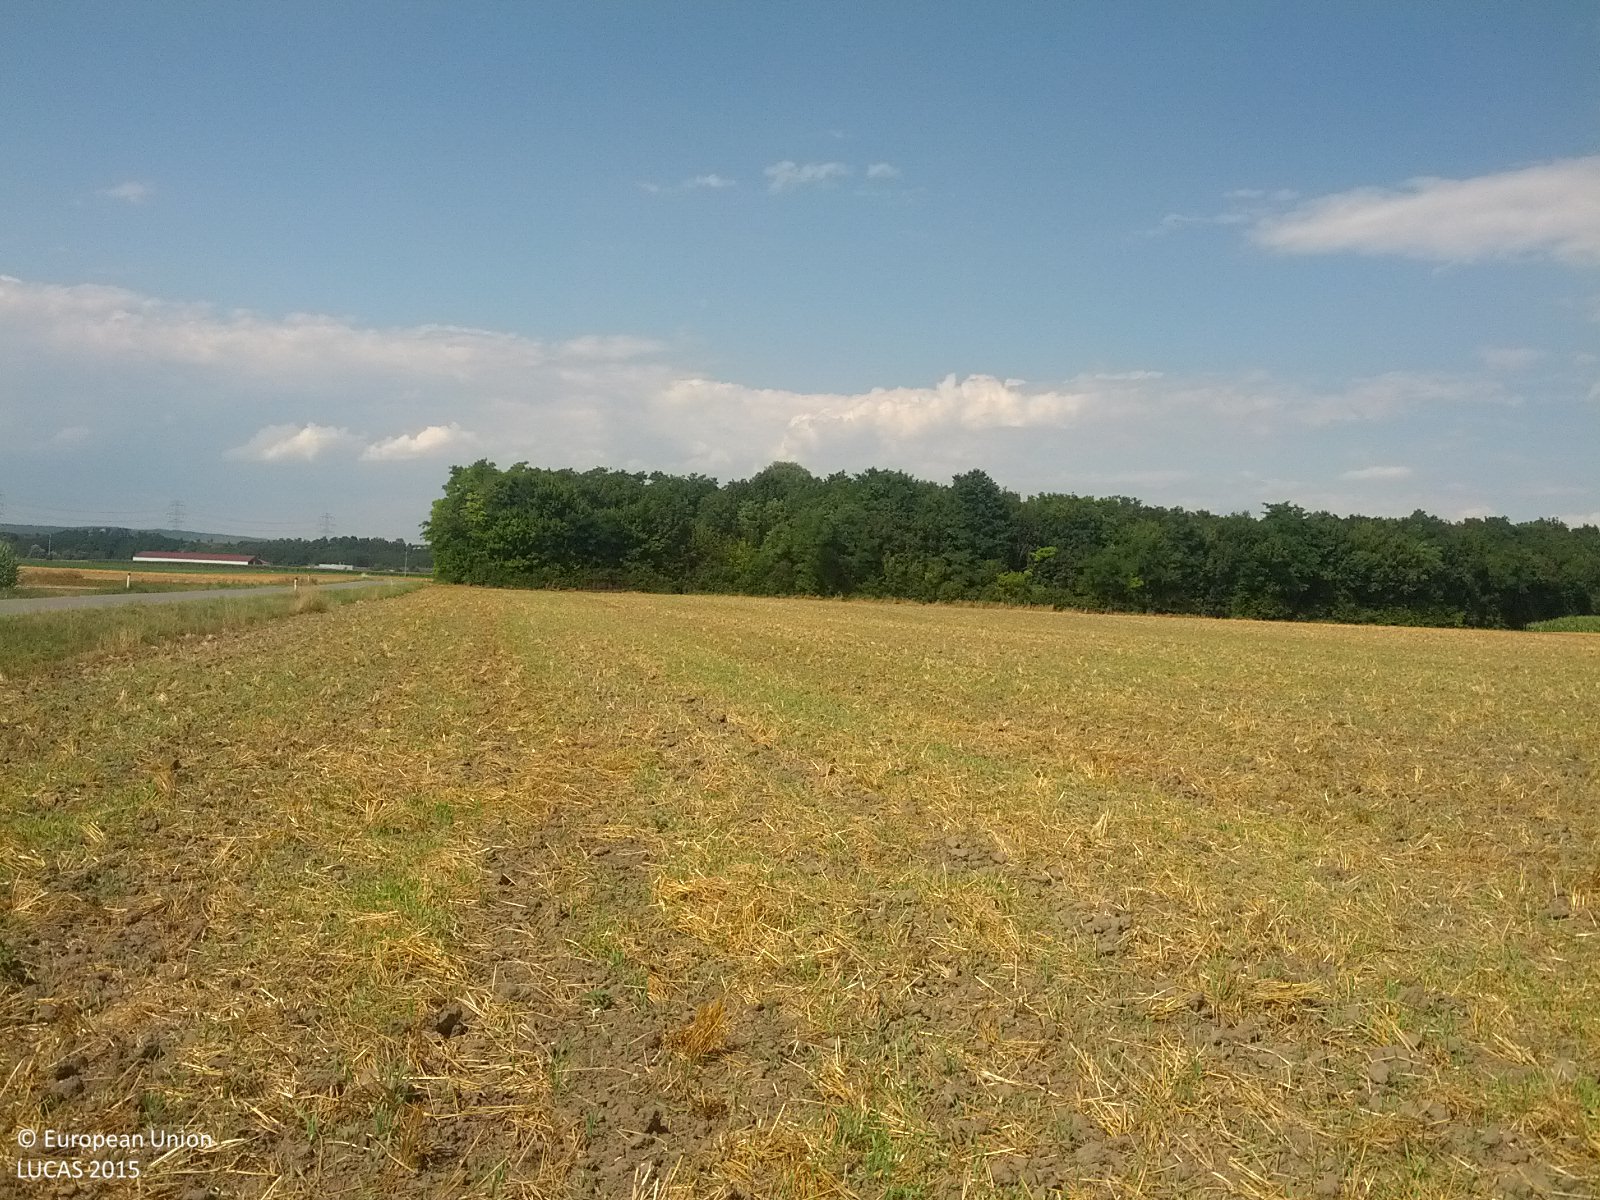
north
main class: Grassland
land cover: Spontaneously vegetated surfaces
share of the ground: < 10 %
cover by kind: unconsolidated bare surface 90 %, herbaceous plants 10 %
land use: Agriculture (excluding fallow land and kitchen gardens)
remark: Harvested field
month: July
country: AT
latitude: 48.3798
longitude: 16.0937
